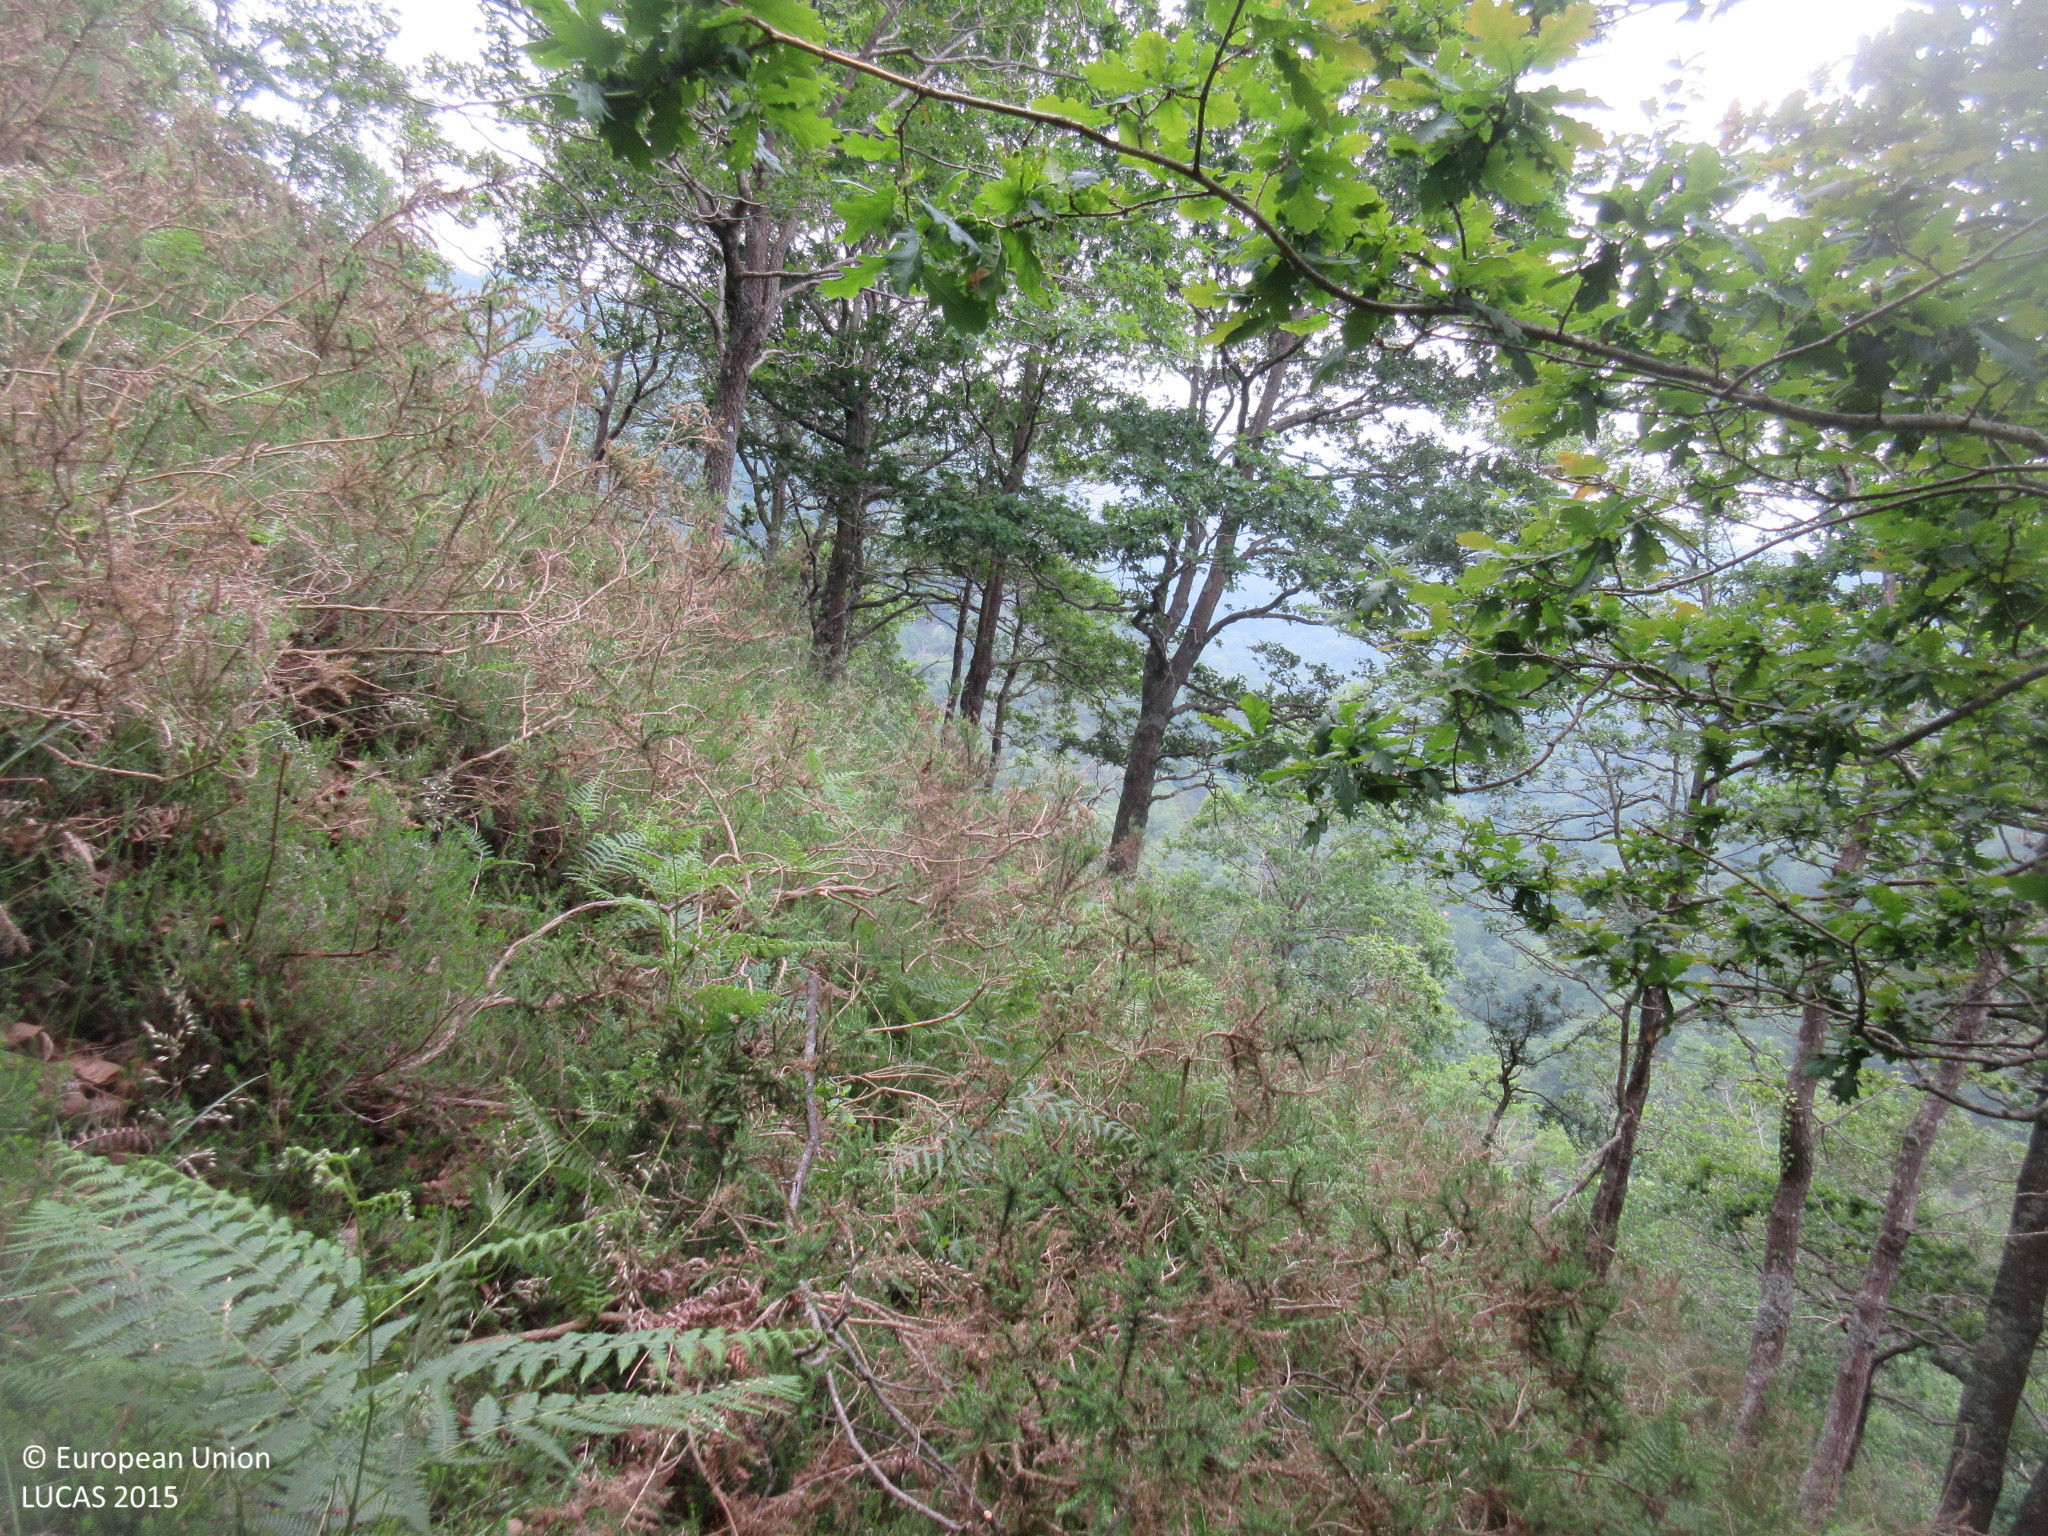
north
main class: Woodland
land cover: Broadleaved woodland
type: acidophilous oak and oak-birch forest
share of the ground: 50 - 75 %
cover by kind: broadleaved forest trees 70 %, shrubs 30 %
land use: Semi-natural and natural areas not in use
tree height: > 5 m
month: June
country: ES
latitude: 43.2220
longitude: -4.1990
